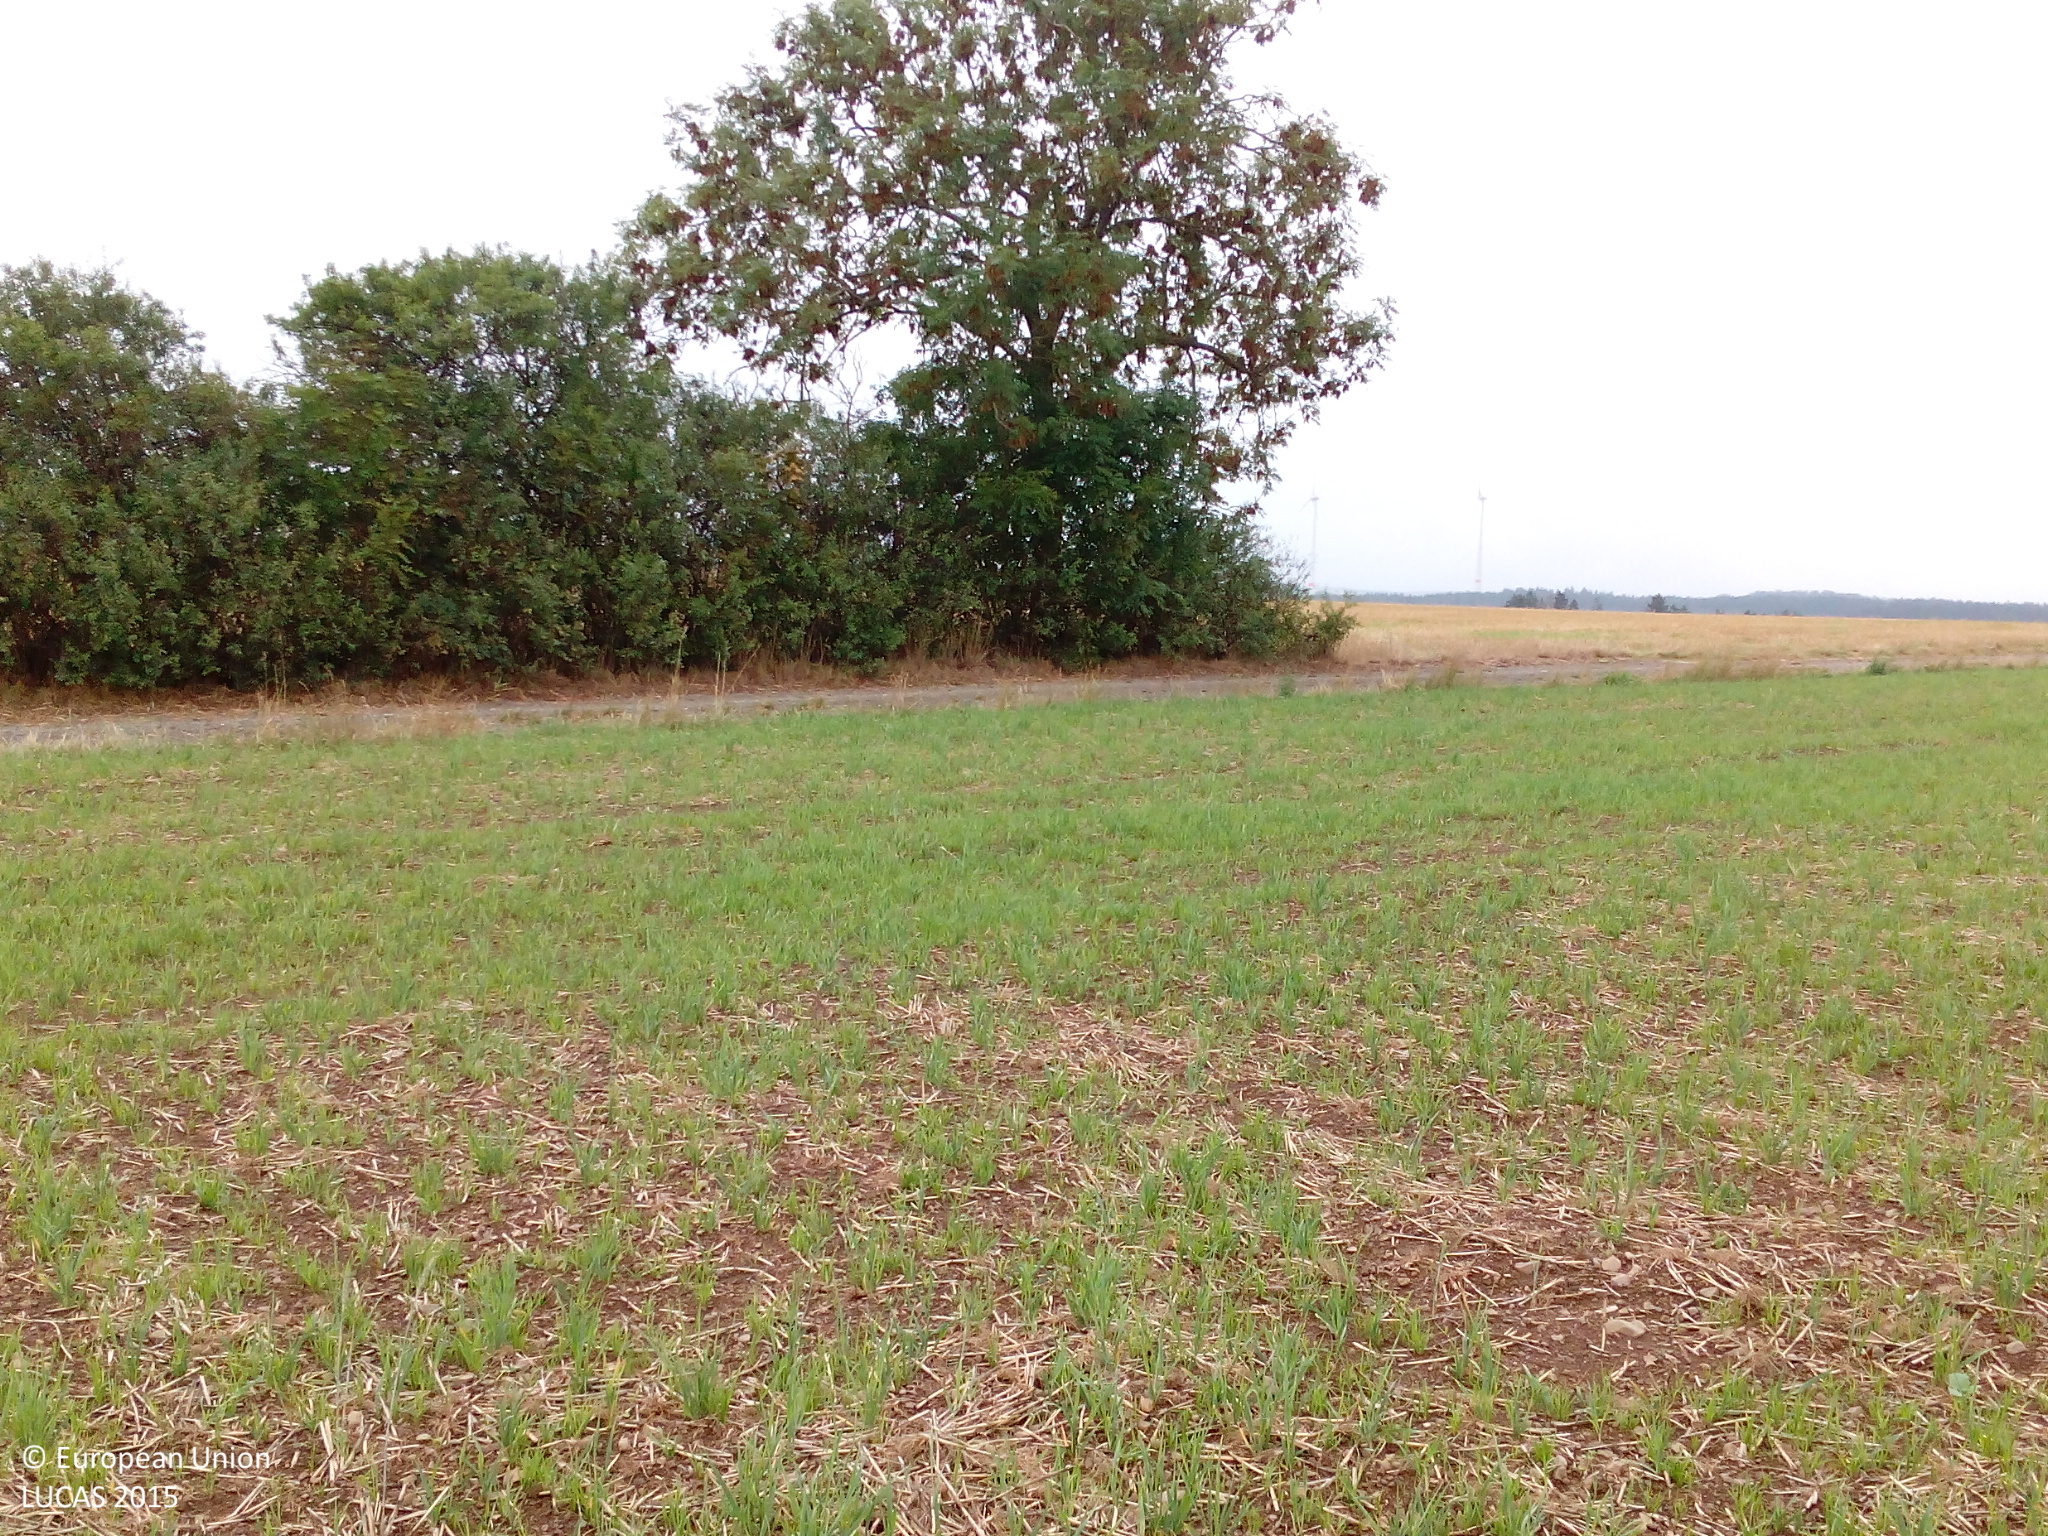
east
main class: Cropland
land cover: Common wheat
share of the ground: 25 - 50 %
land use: Agriculture (excluding fallow land and kitchen gardens)
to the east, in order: Common wheat; Tracks; Abandoned hedges; Barley
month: August
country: DE
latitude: 50.3110
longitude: 11.9796
